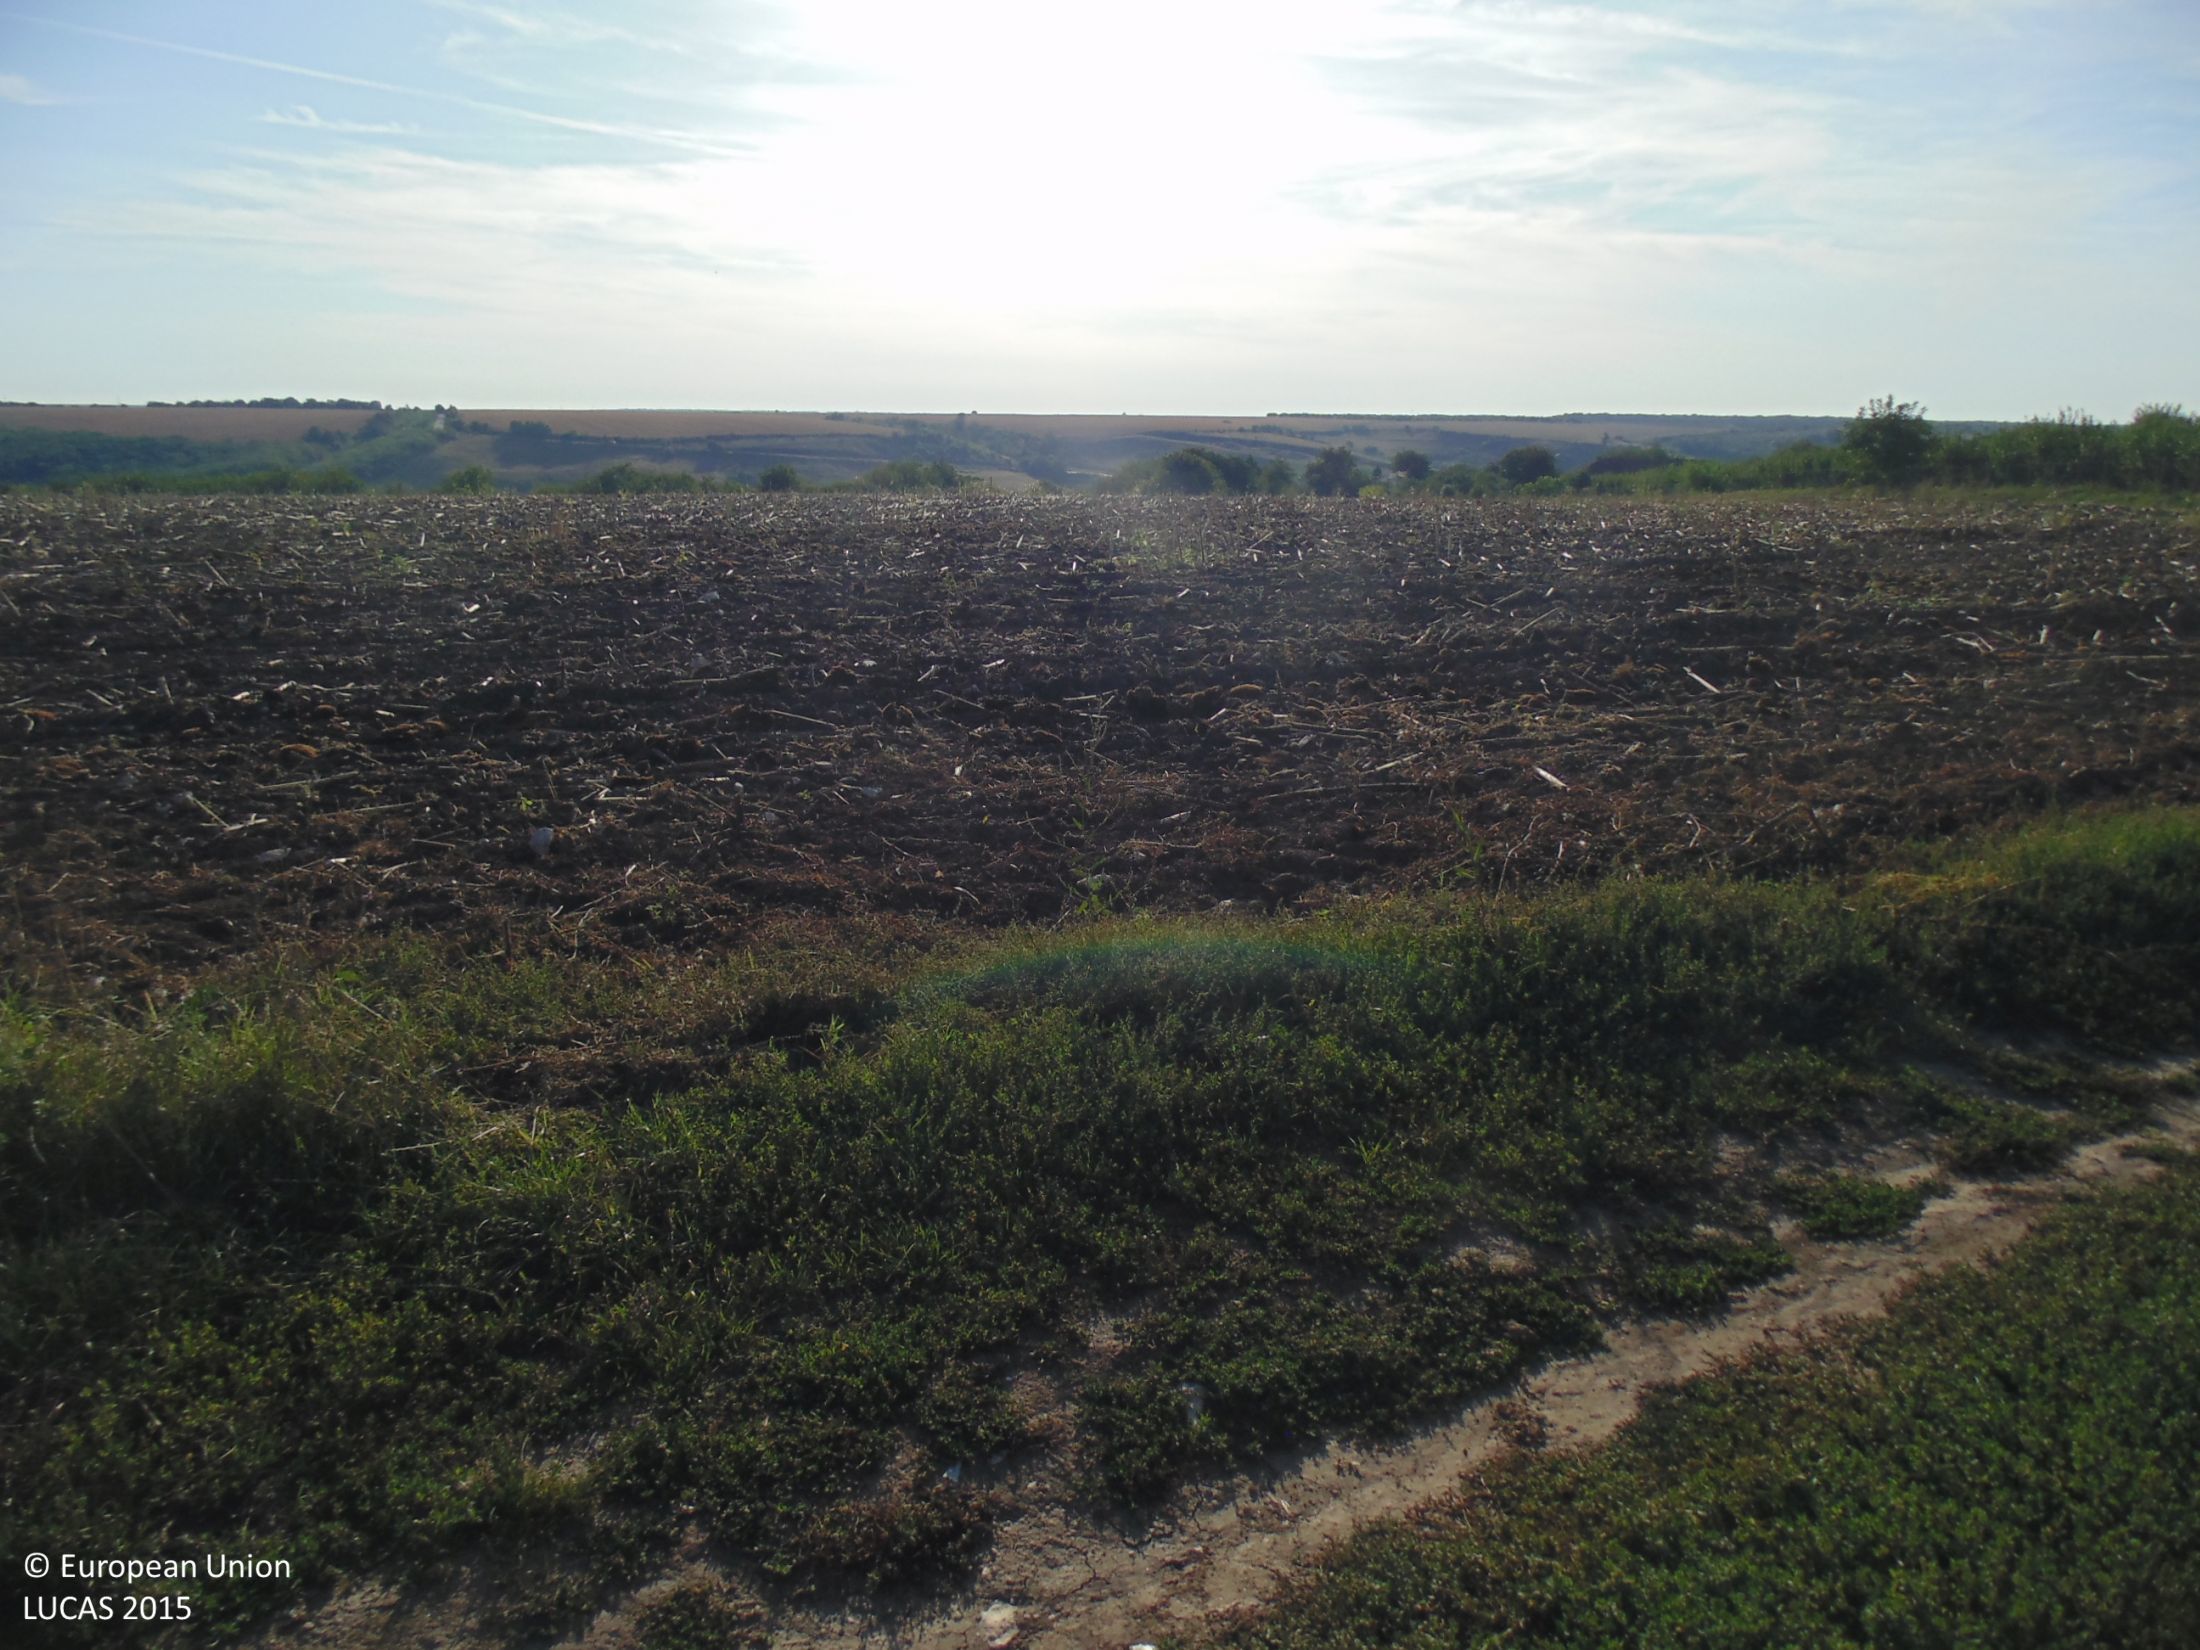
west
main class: Grassland
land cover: Grassland with sparse tree/shrub cover
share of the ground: > 75 %
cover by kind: herbaceous plants 95 %, broadleaved forest trees 5 %
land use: Semi-natural and natural areas not in use
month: September
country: BG
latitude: 44.0623
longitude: 26.8613
